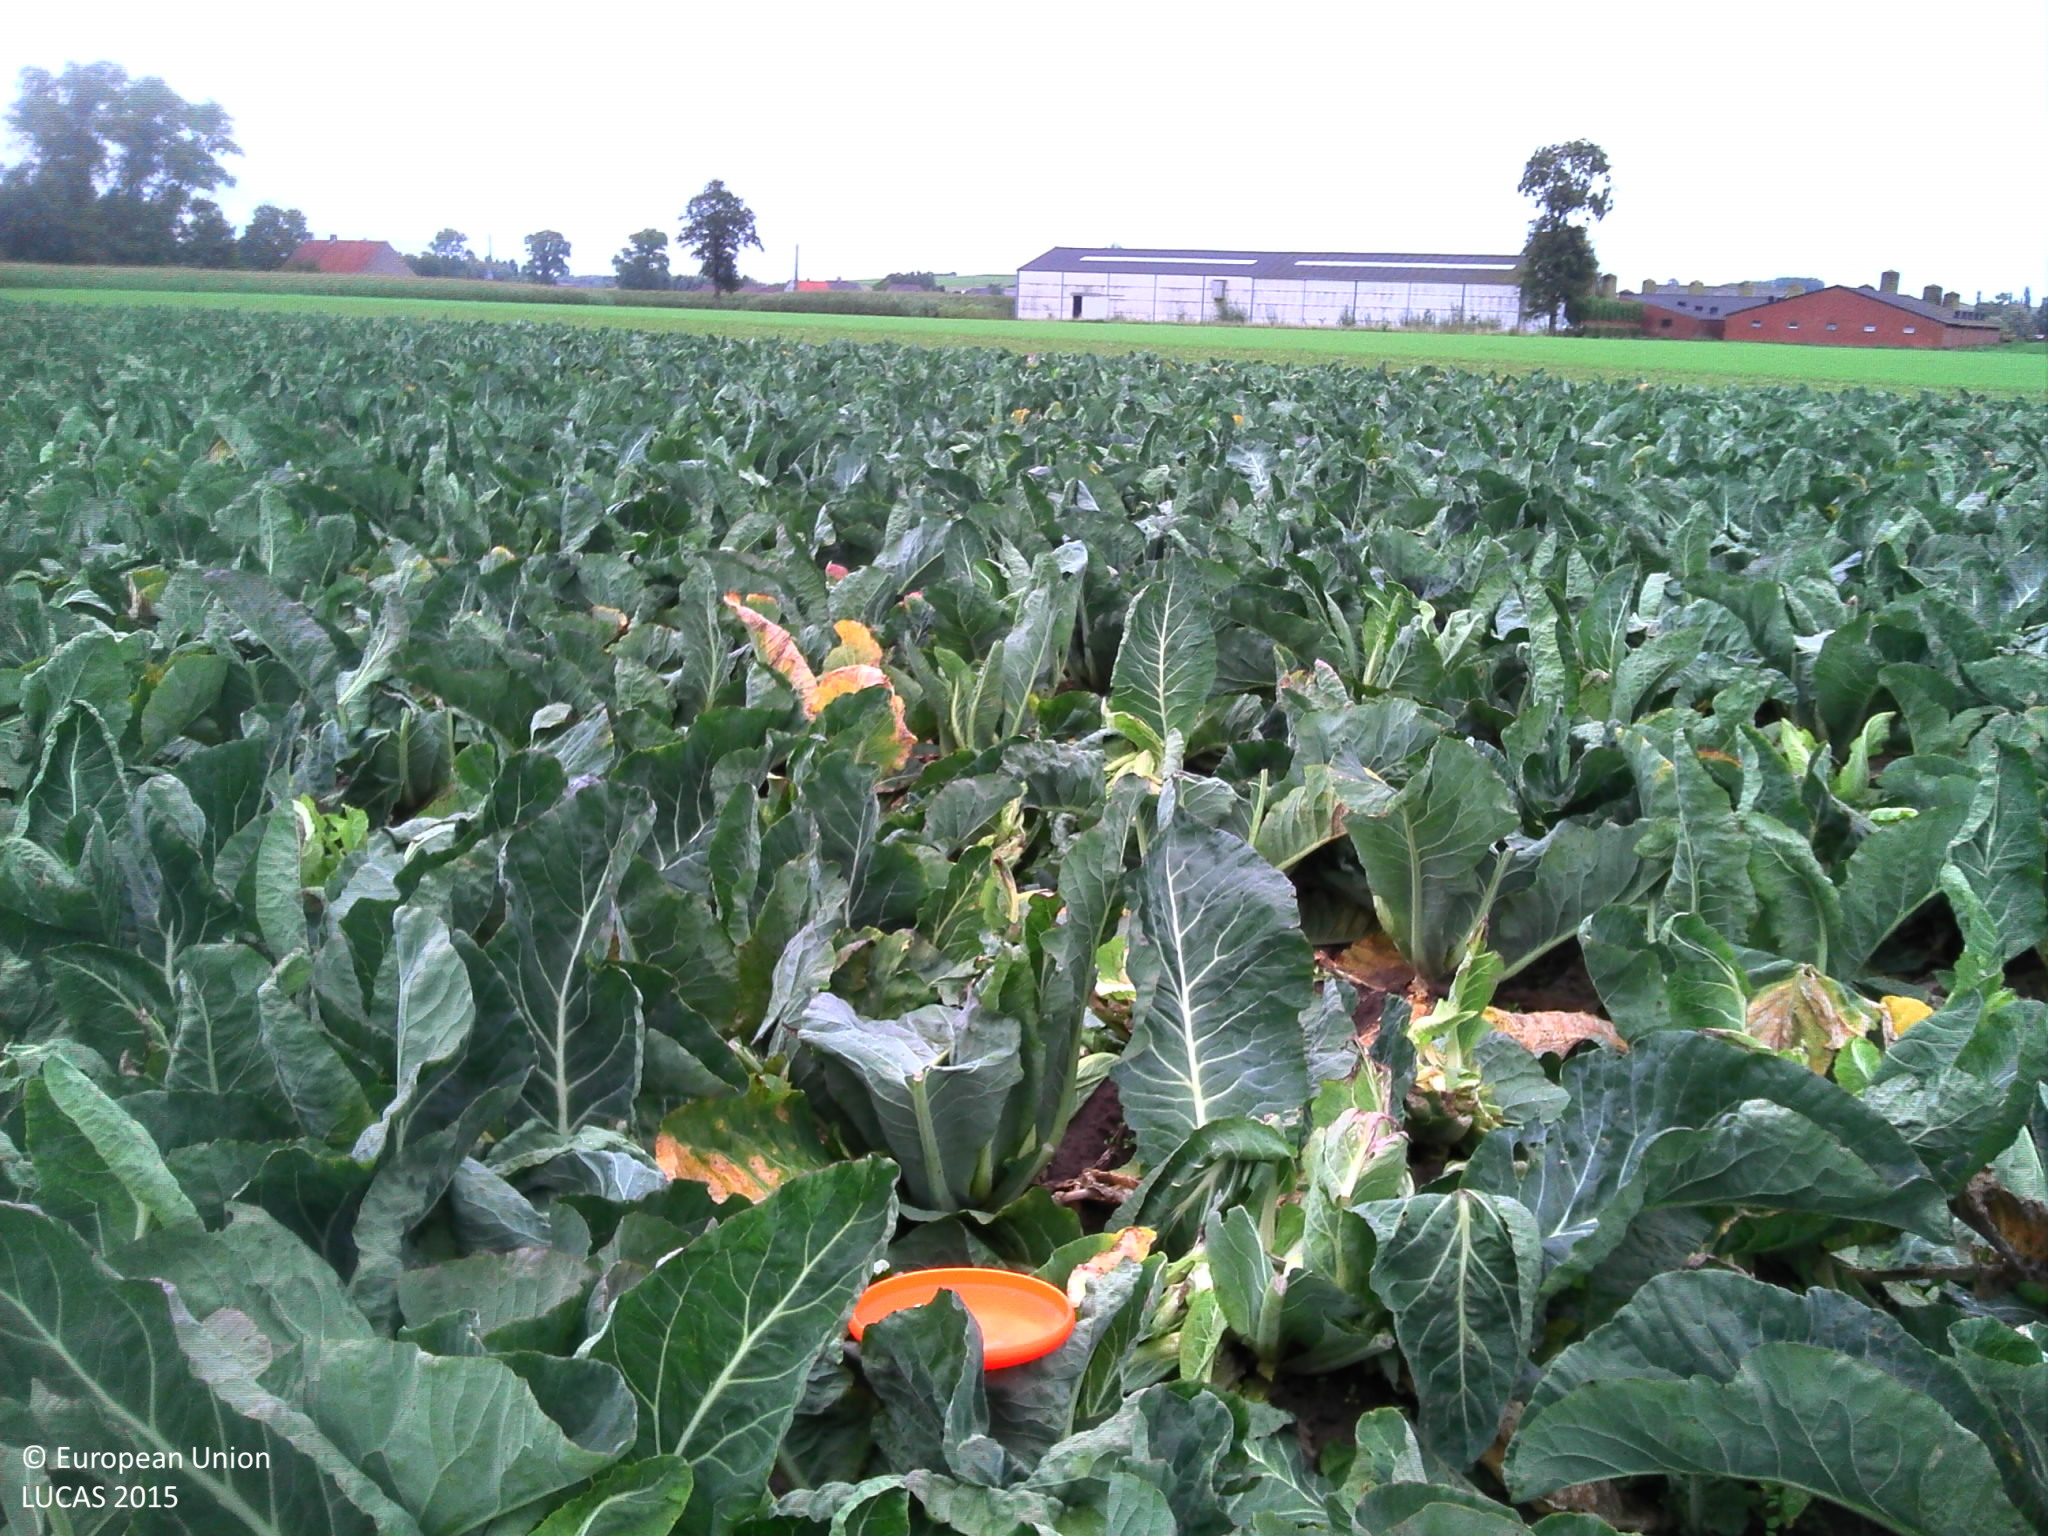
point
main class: Cropland
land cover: Other fresh vegetables
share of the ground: > 75 %
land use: Agriculture (excluding fallow land and kitchen gardens)
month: September
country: BE
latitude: 51.0690
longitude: 2.9828
